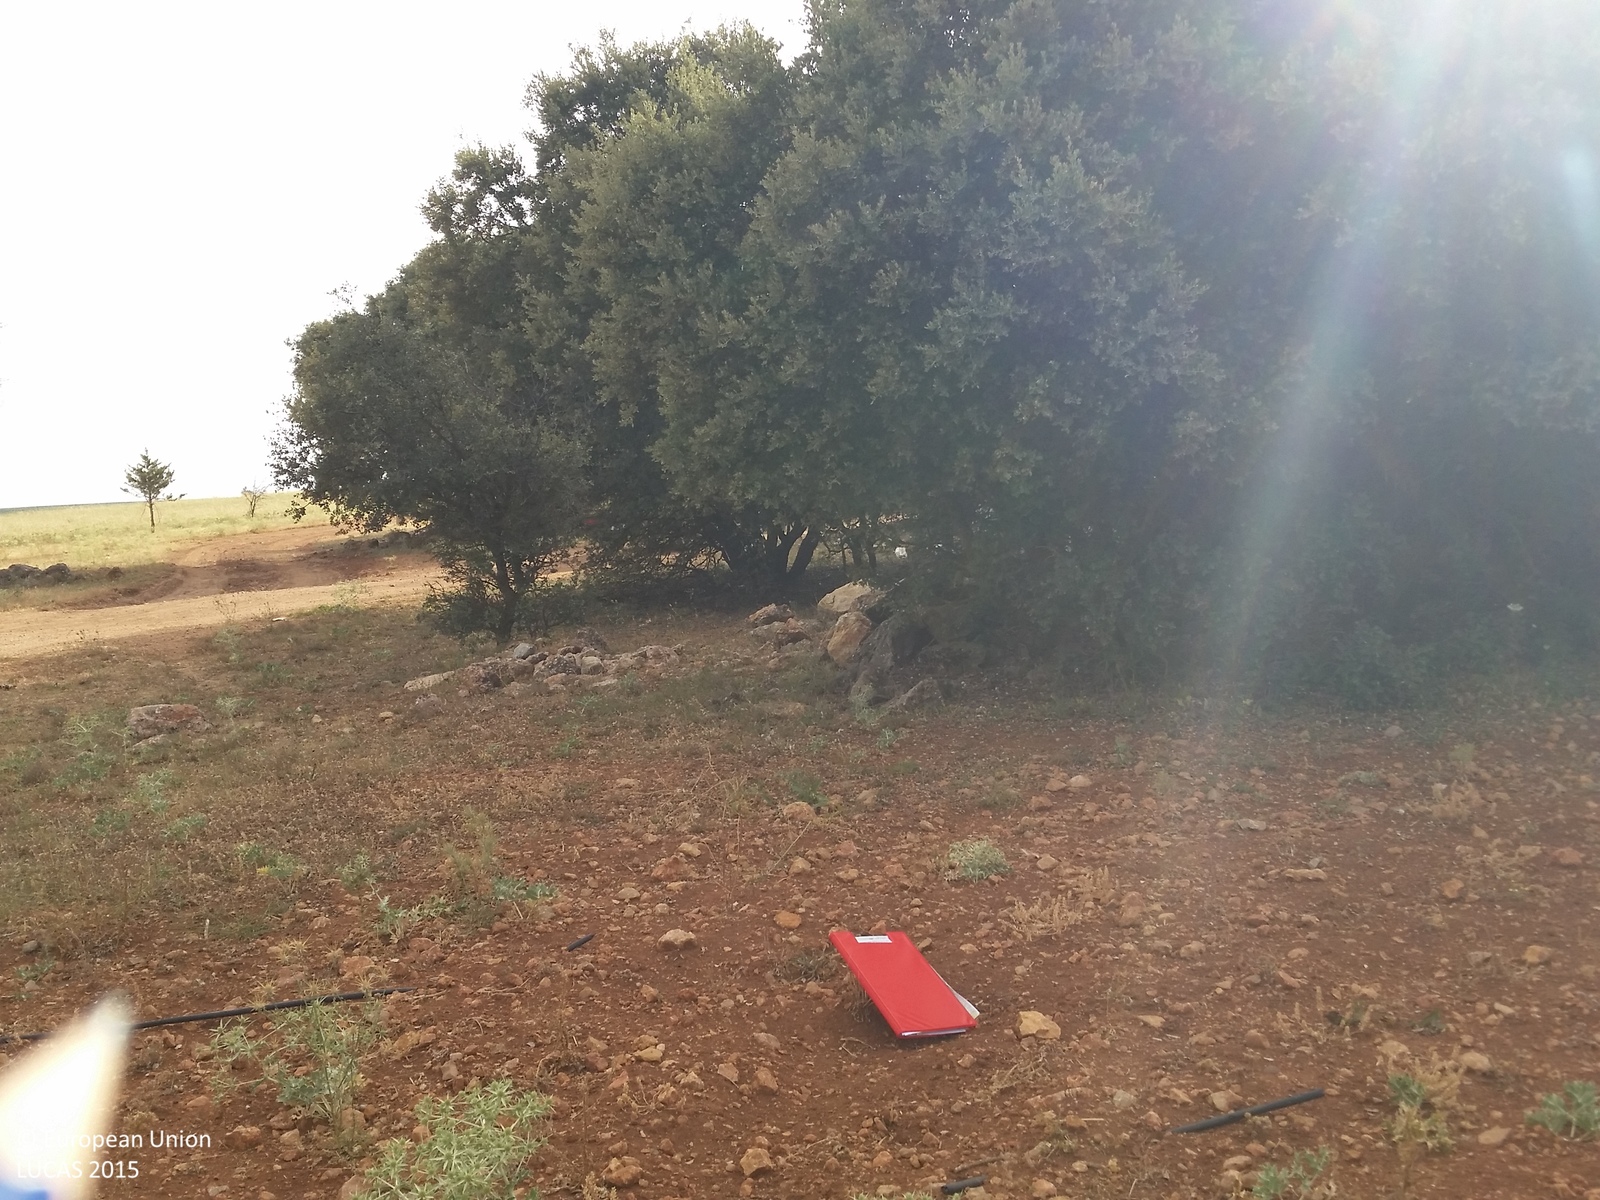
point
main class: Woodland
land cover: Broadleaved woodland
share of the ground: 50 - 75 %
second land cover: Spontaneously vegetated surfaces
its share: 25 - 50 %
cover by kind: broadleaved forest trees 60 %, herbaceous plants 30 %, unconsolidated bare surface 10 %
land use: Forestry
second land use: Fallow land
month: July
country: ES
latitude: 38.7438
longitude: -2.5550
